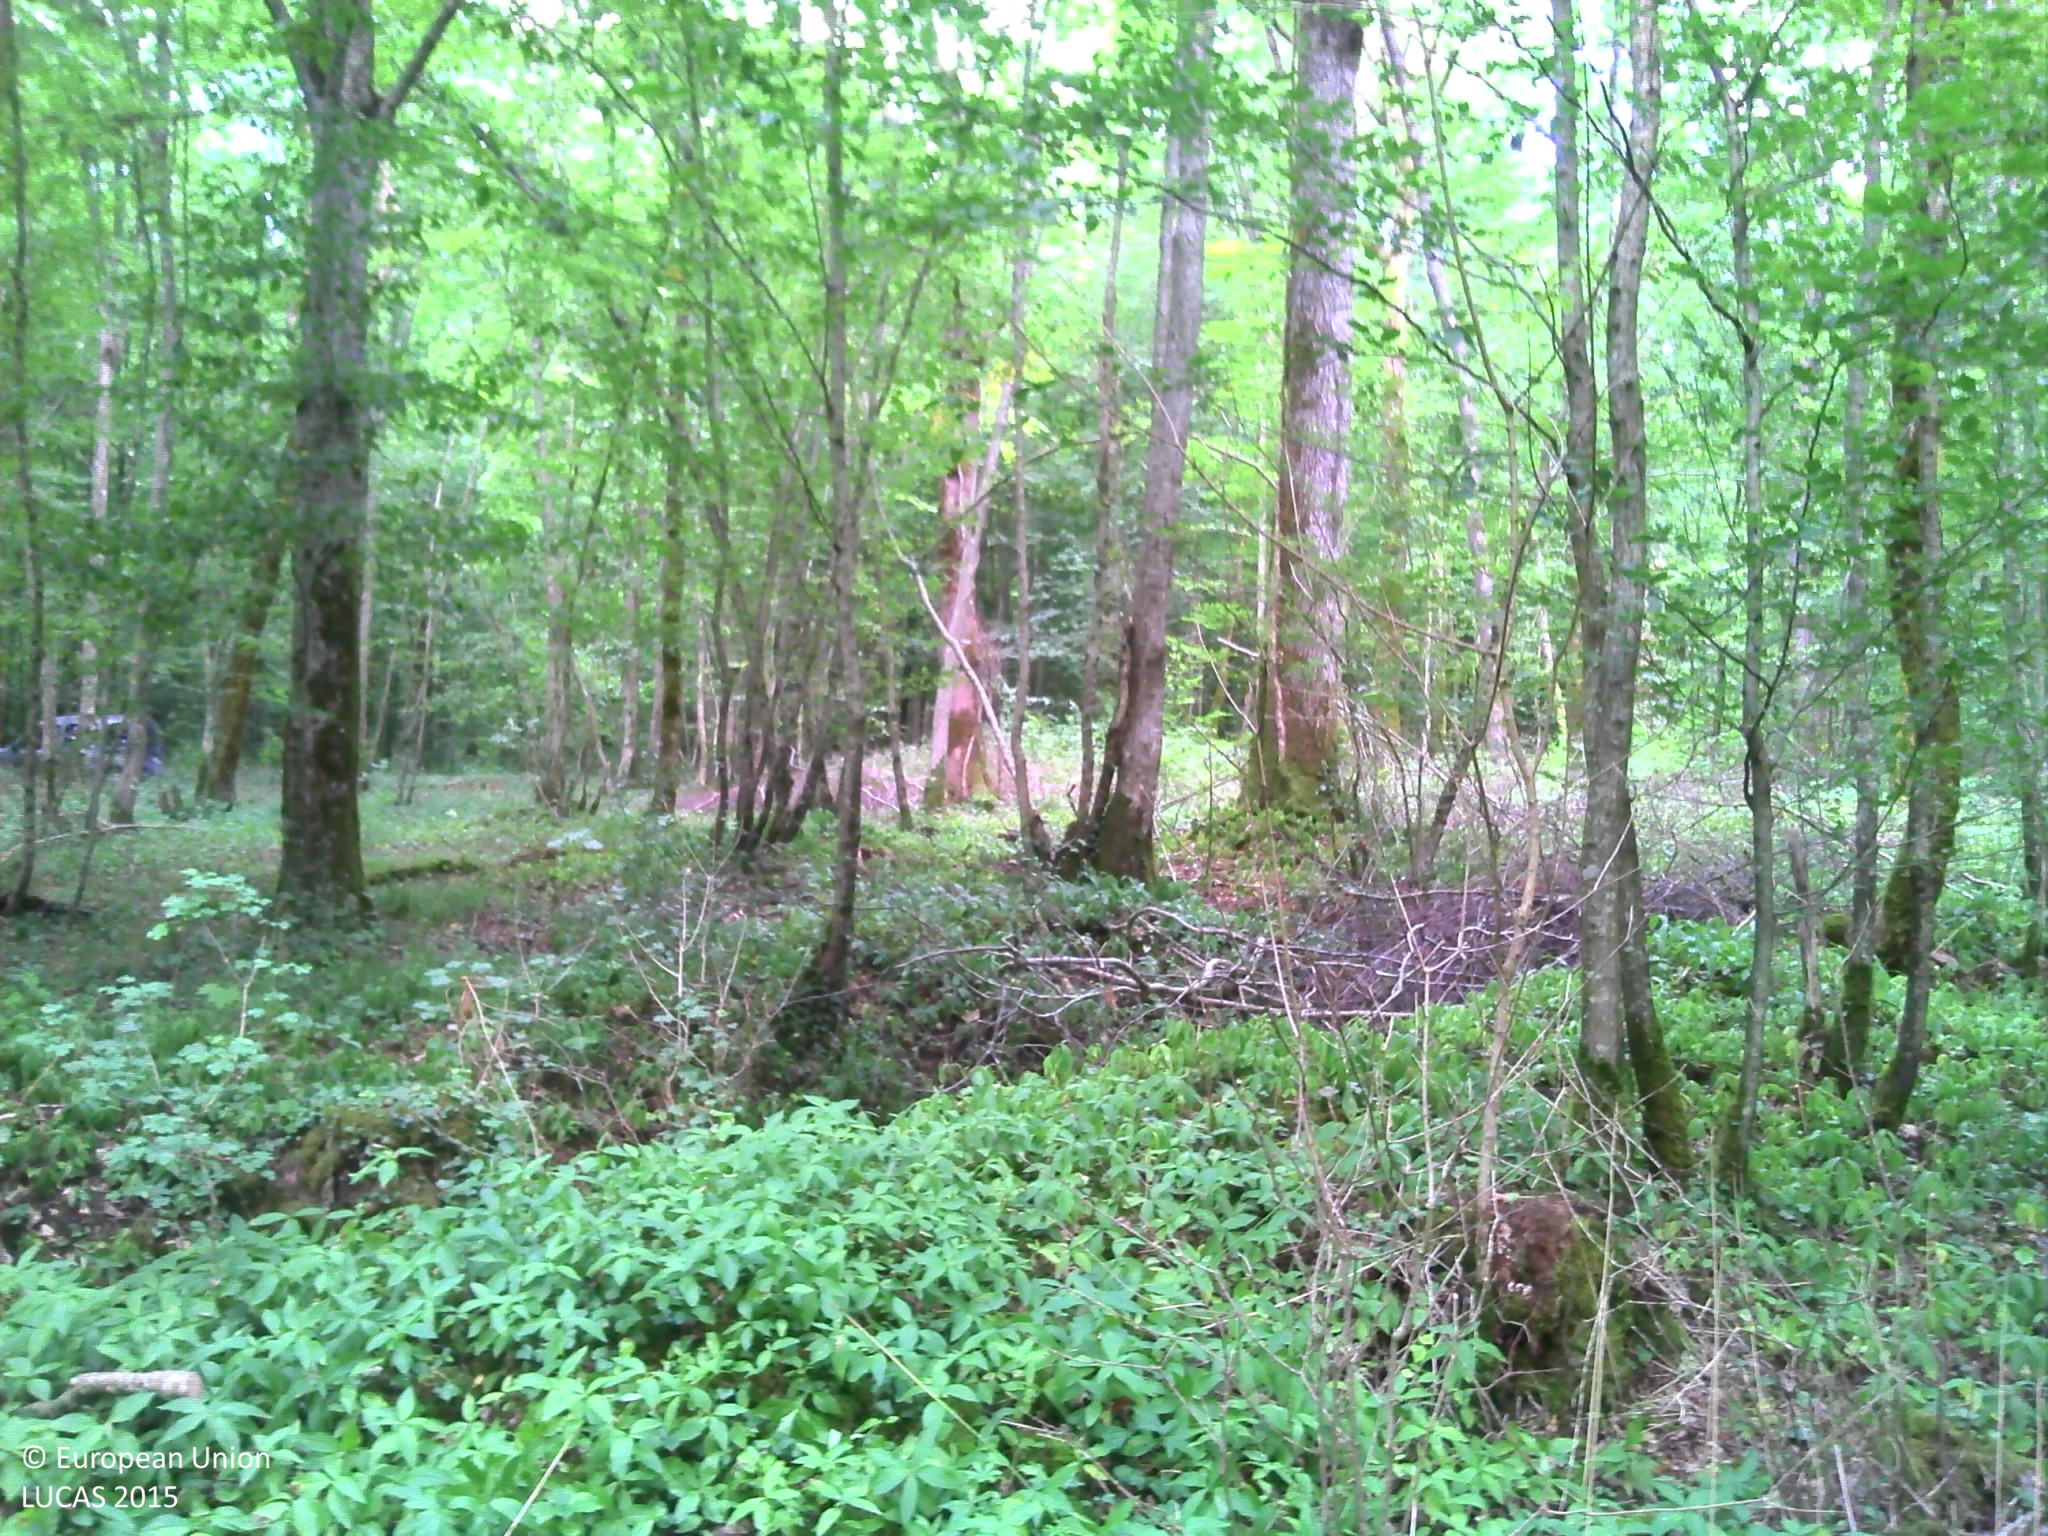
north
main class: Woodland
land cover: Broadleaved woodland
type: mesophytic deciduous forest
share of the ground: > 75 %
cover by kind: broadleaved forest trees 95 %, herbaceous plants 5 %
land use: Forestry
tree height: > 5 m
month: July
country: FR
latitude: 49.1805
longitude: 5.1554
